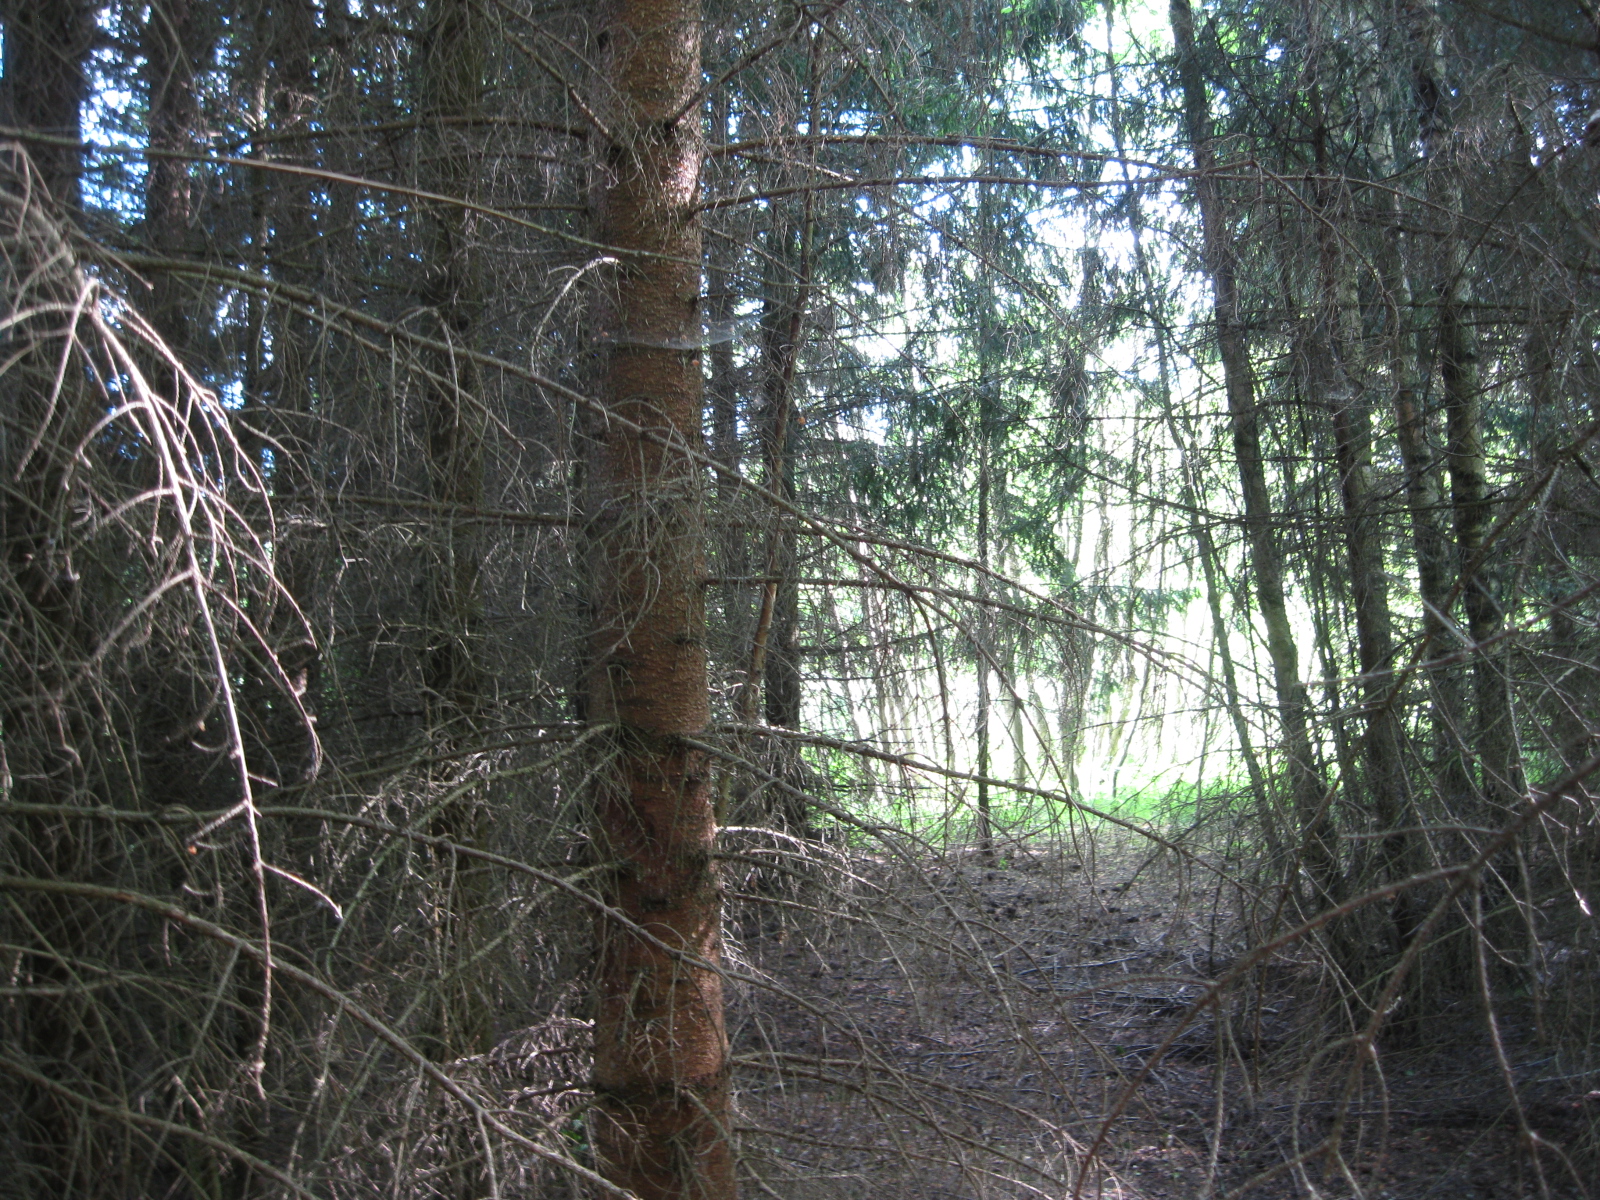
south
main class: Woodland
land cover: Spruce dominated mixed woodland
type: hemiboreal forest and nemoral coniferous forest and mixed broadleaved-coniferous forest
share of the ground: > 75 %
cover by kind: coniferous forest trees 65 %, broadleaved forest trees 30 %, unconsolidated bare surface 5 %
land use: Forestry
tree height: > 5 m
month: June
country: LT
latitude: 55.5922
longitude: 23.5515
